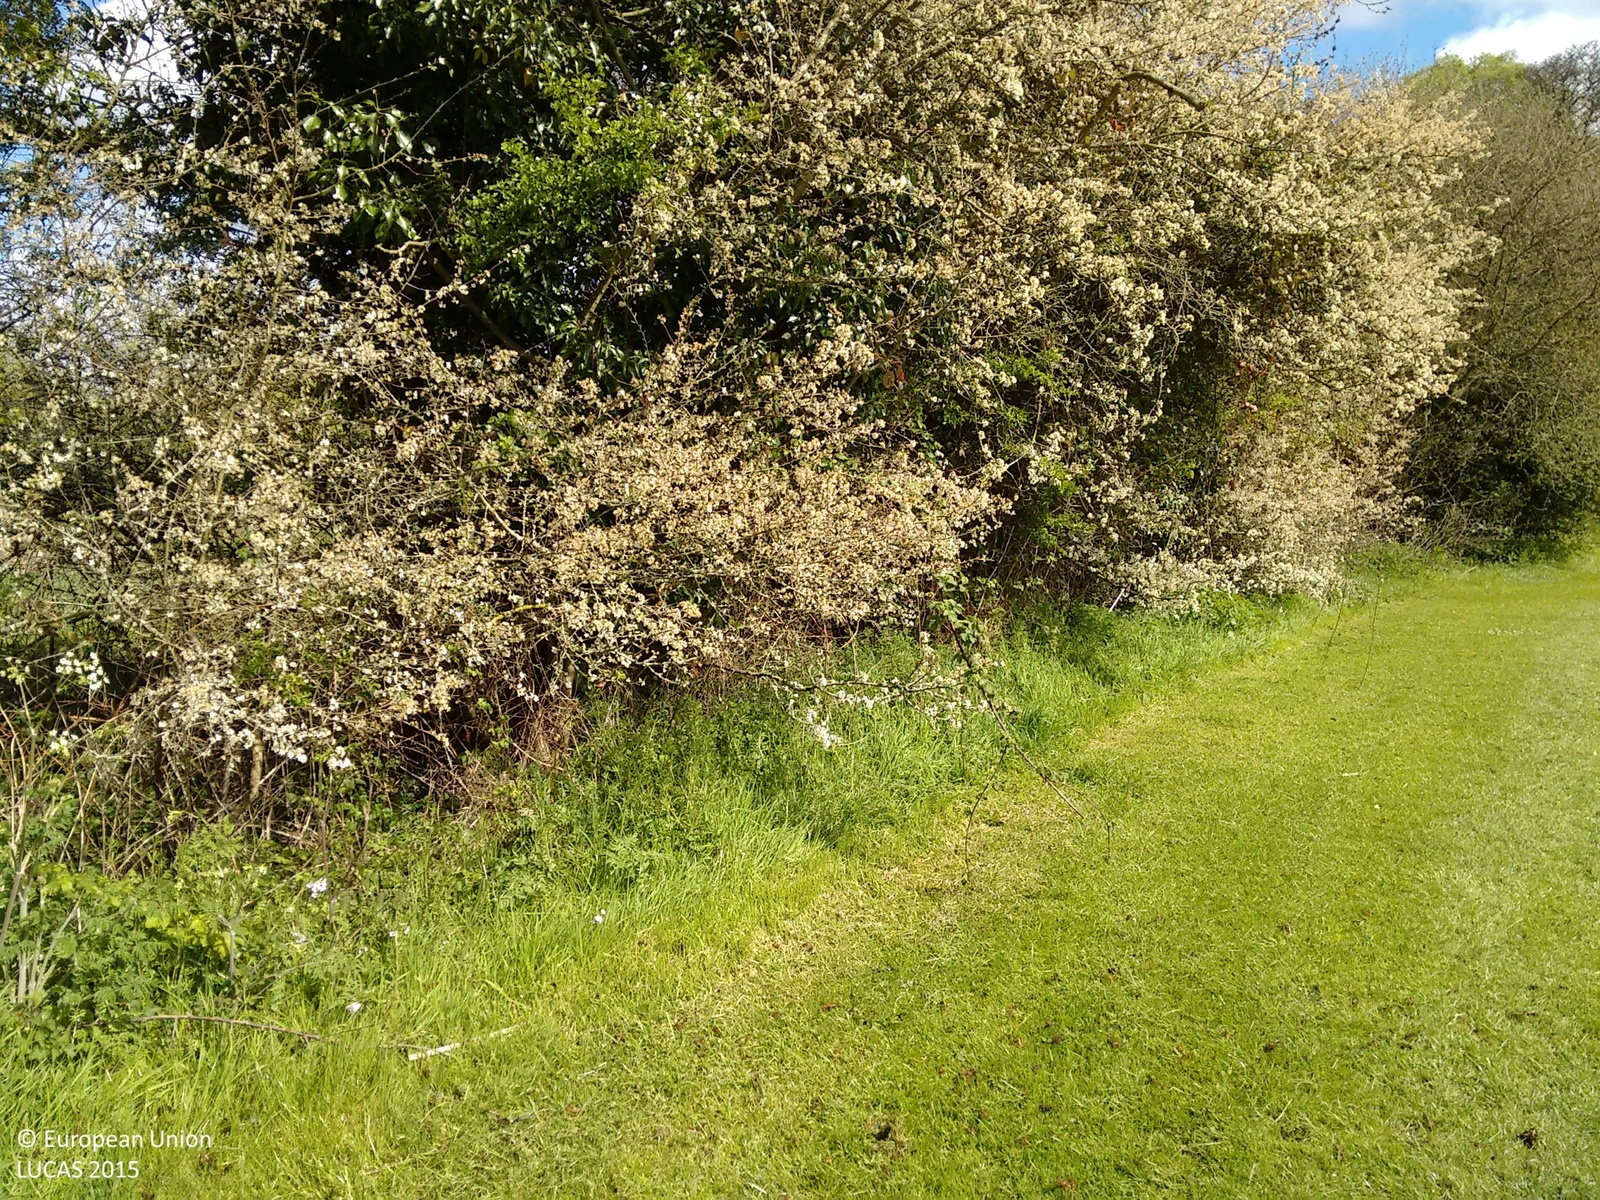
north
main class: Grassland
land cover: Grassland without tree/shrub cover
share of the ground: > 75 %
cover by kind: herbaceous plants 100 %
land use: Semi-natural and natural areas not in use
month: April
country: GB
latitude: 52.3191
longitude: -1.9257
